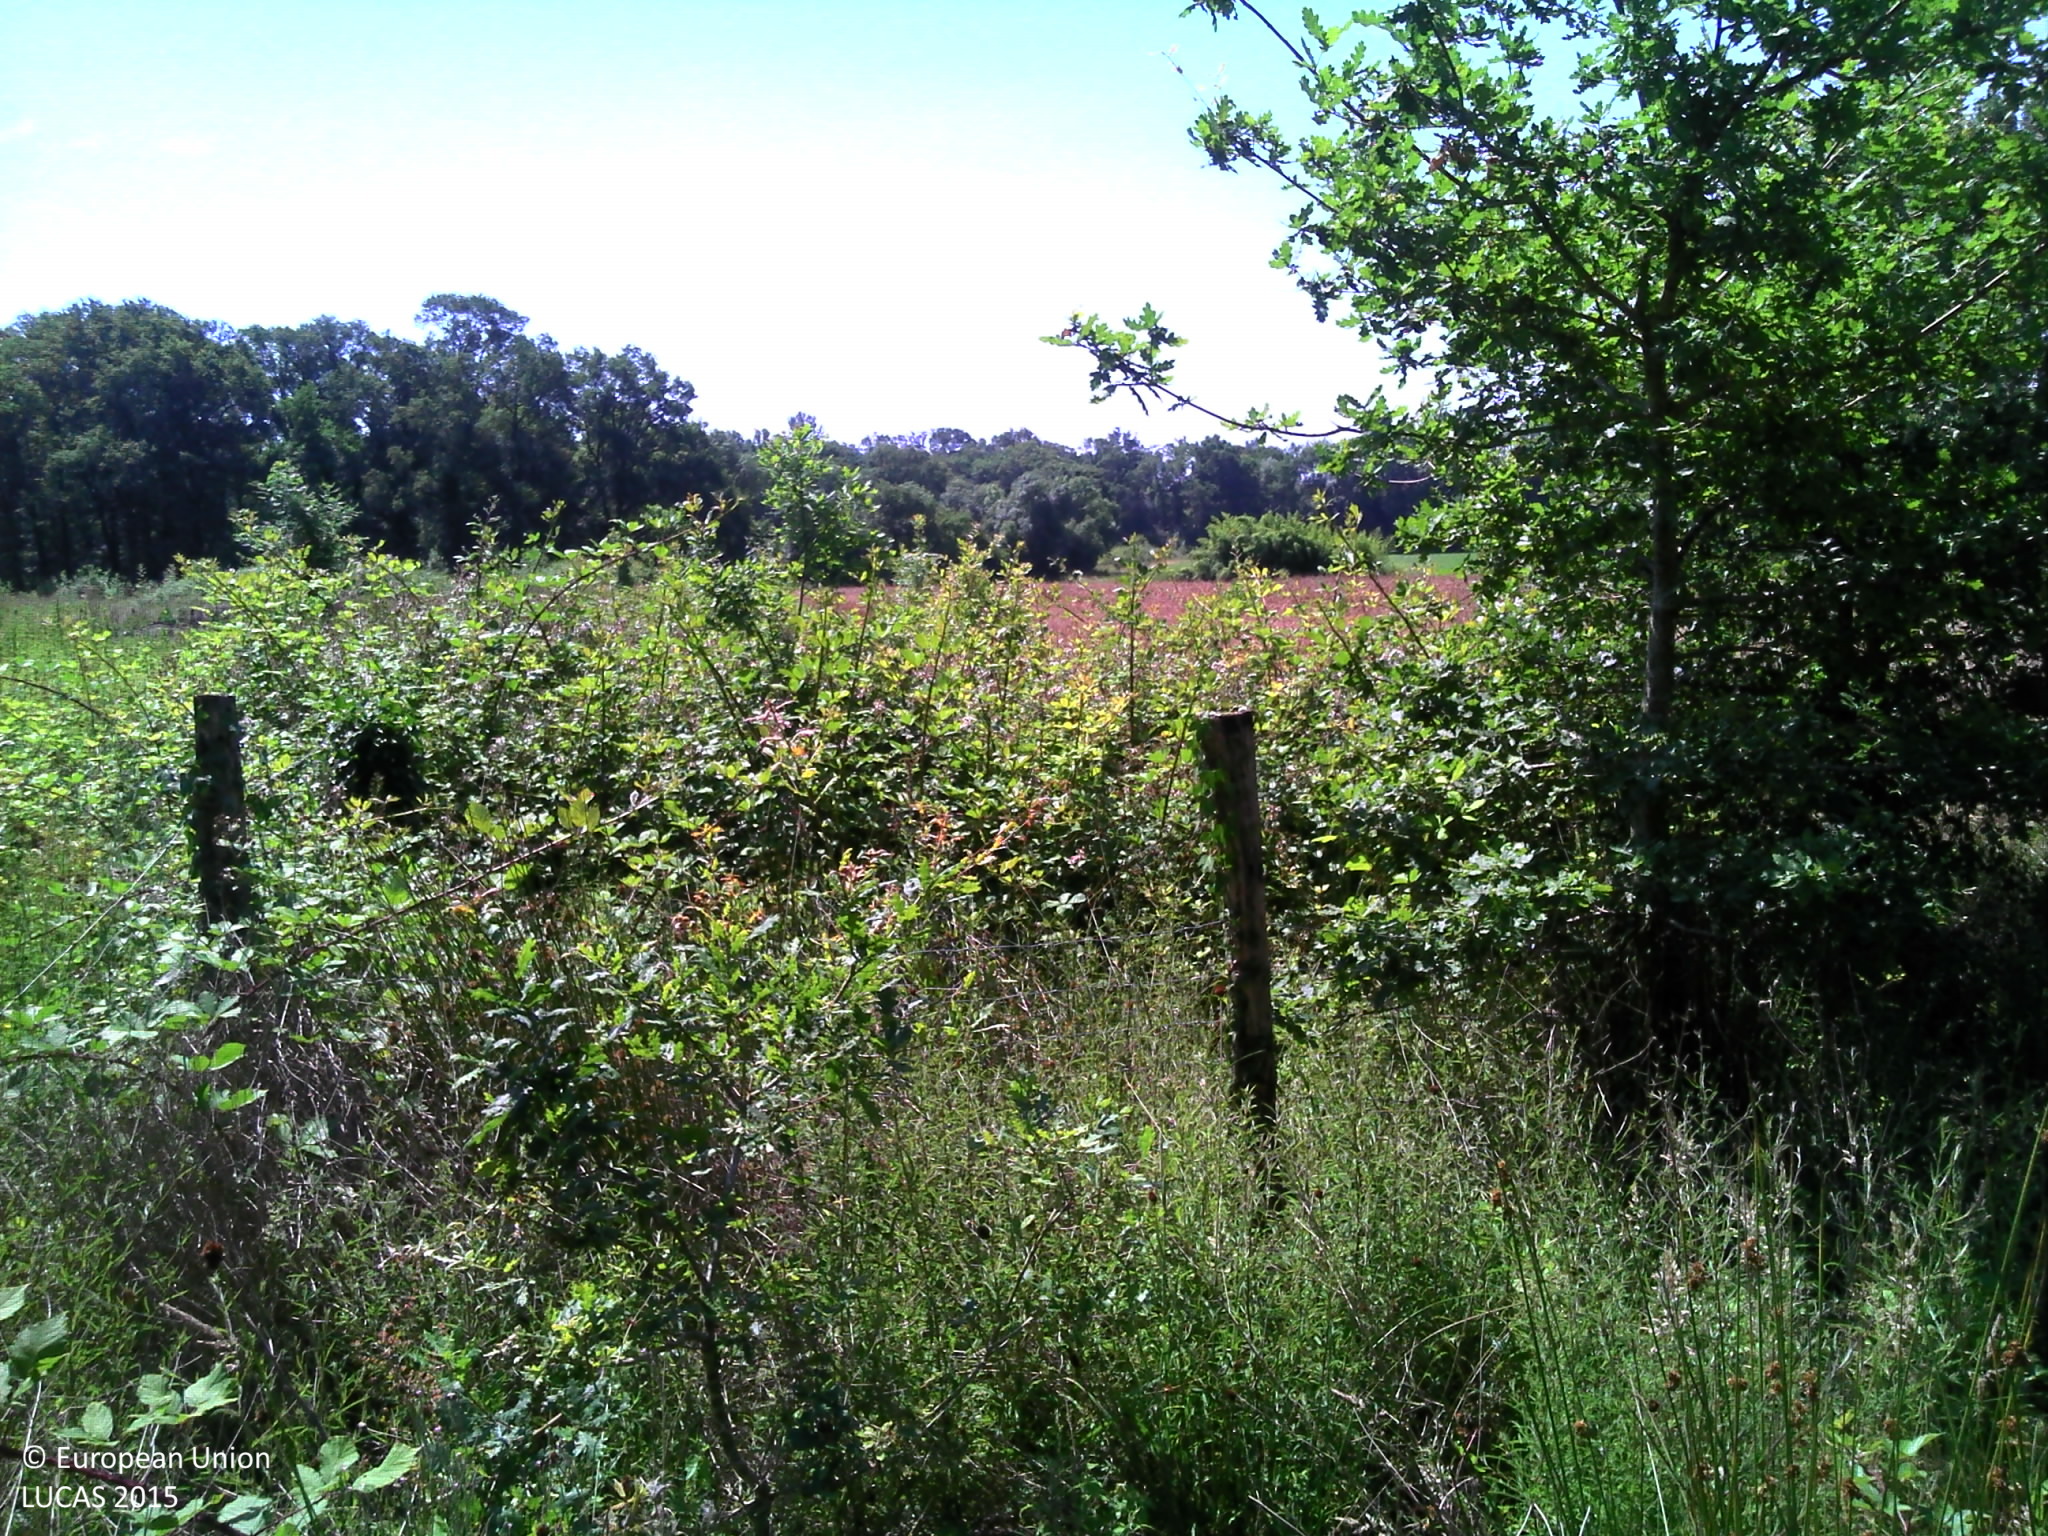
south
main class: Shrubland
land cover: Shrubland without tree cover
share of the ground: > 75 %
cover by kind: shrubs 55 %, herbaceous plants 45 %
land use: Abandoned areas
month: June
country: FR
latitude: 43.6465
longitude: -0.5610
